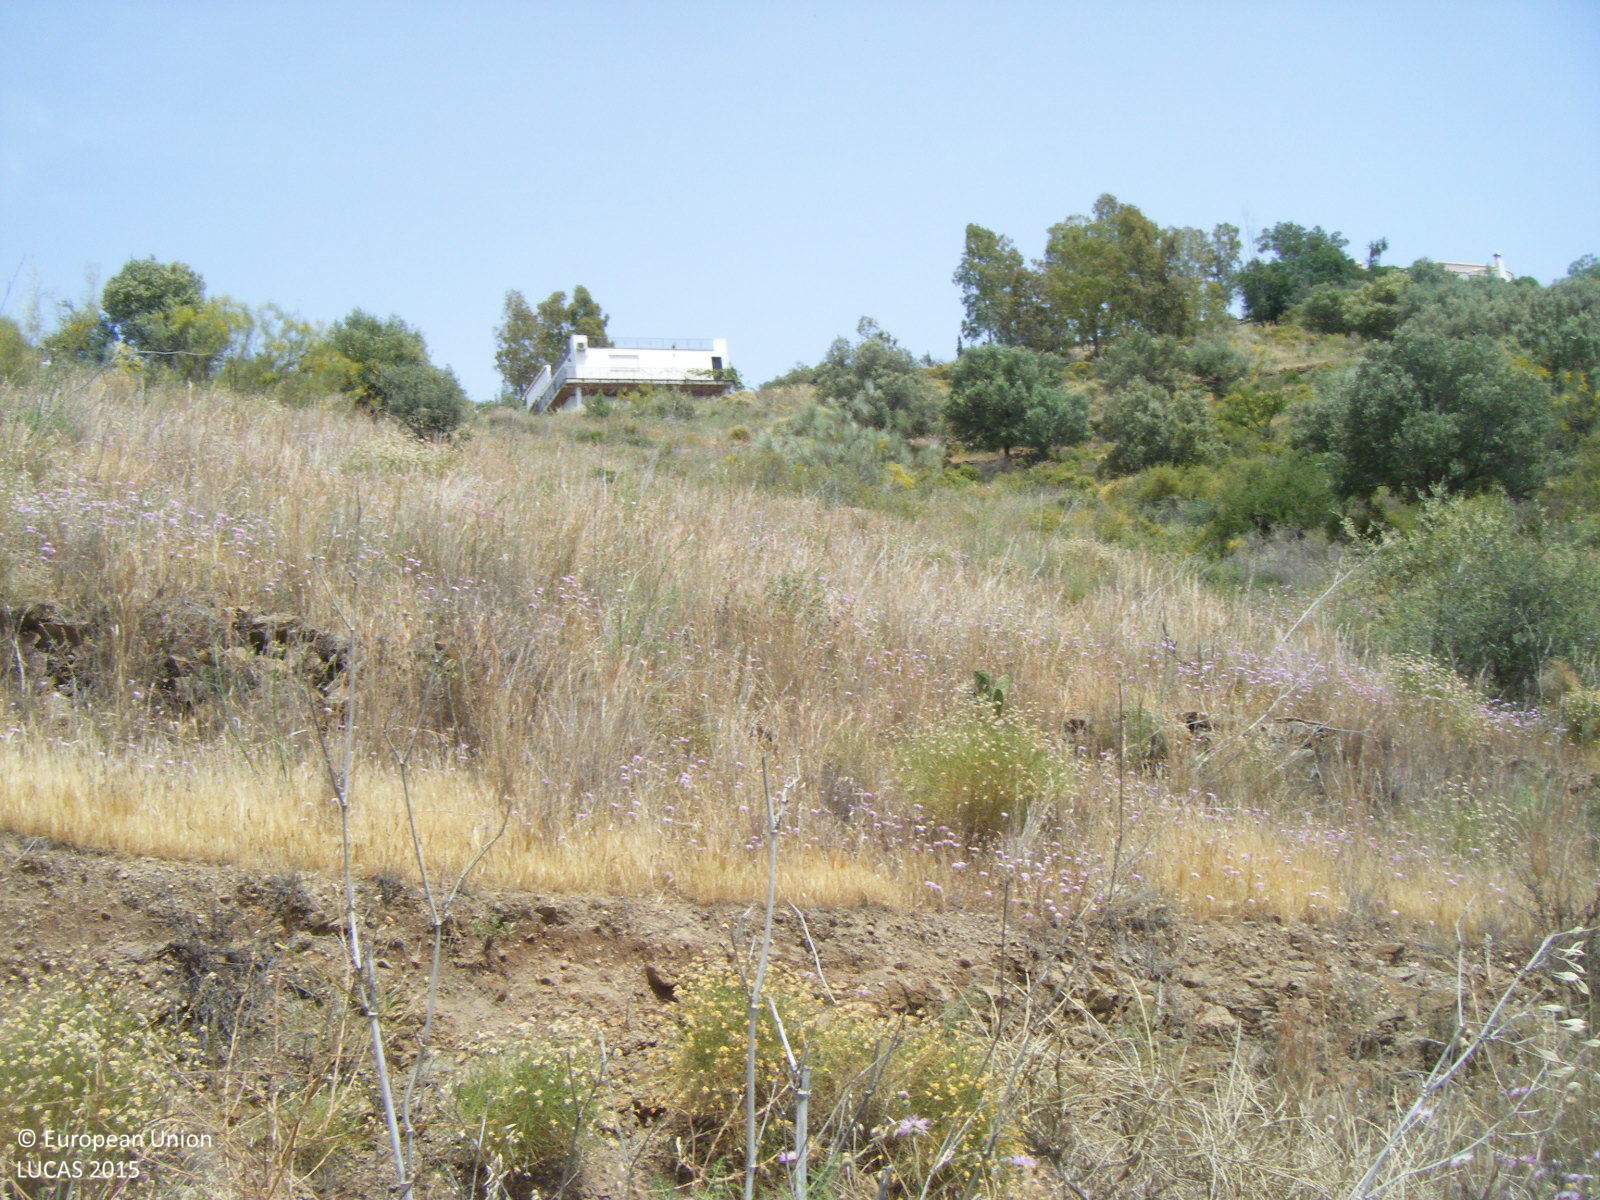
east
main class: Grassland
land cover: Grassland without tree/shrub cover
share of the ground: > 75 %
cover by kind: herbaceous plants 95 %, shrubs 5 %
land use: Semi-natural and natural areas not in use
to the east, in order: Grassland without tree/shrub cover; Tracks; Shrubland without tree cover; Olive groves; Tracks; Grassland without tree/shrub cover; Broadleaved woodland; Tracks; Broadleaved woodland; Tracks; Olive groves
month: May
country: ES
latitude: 36.7793
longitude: -4.0036
